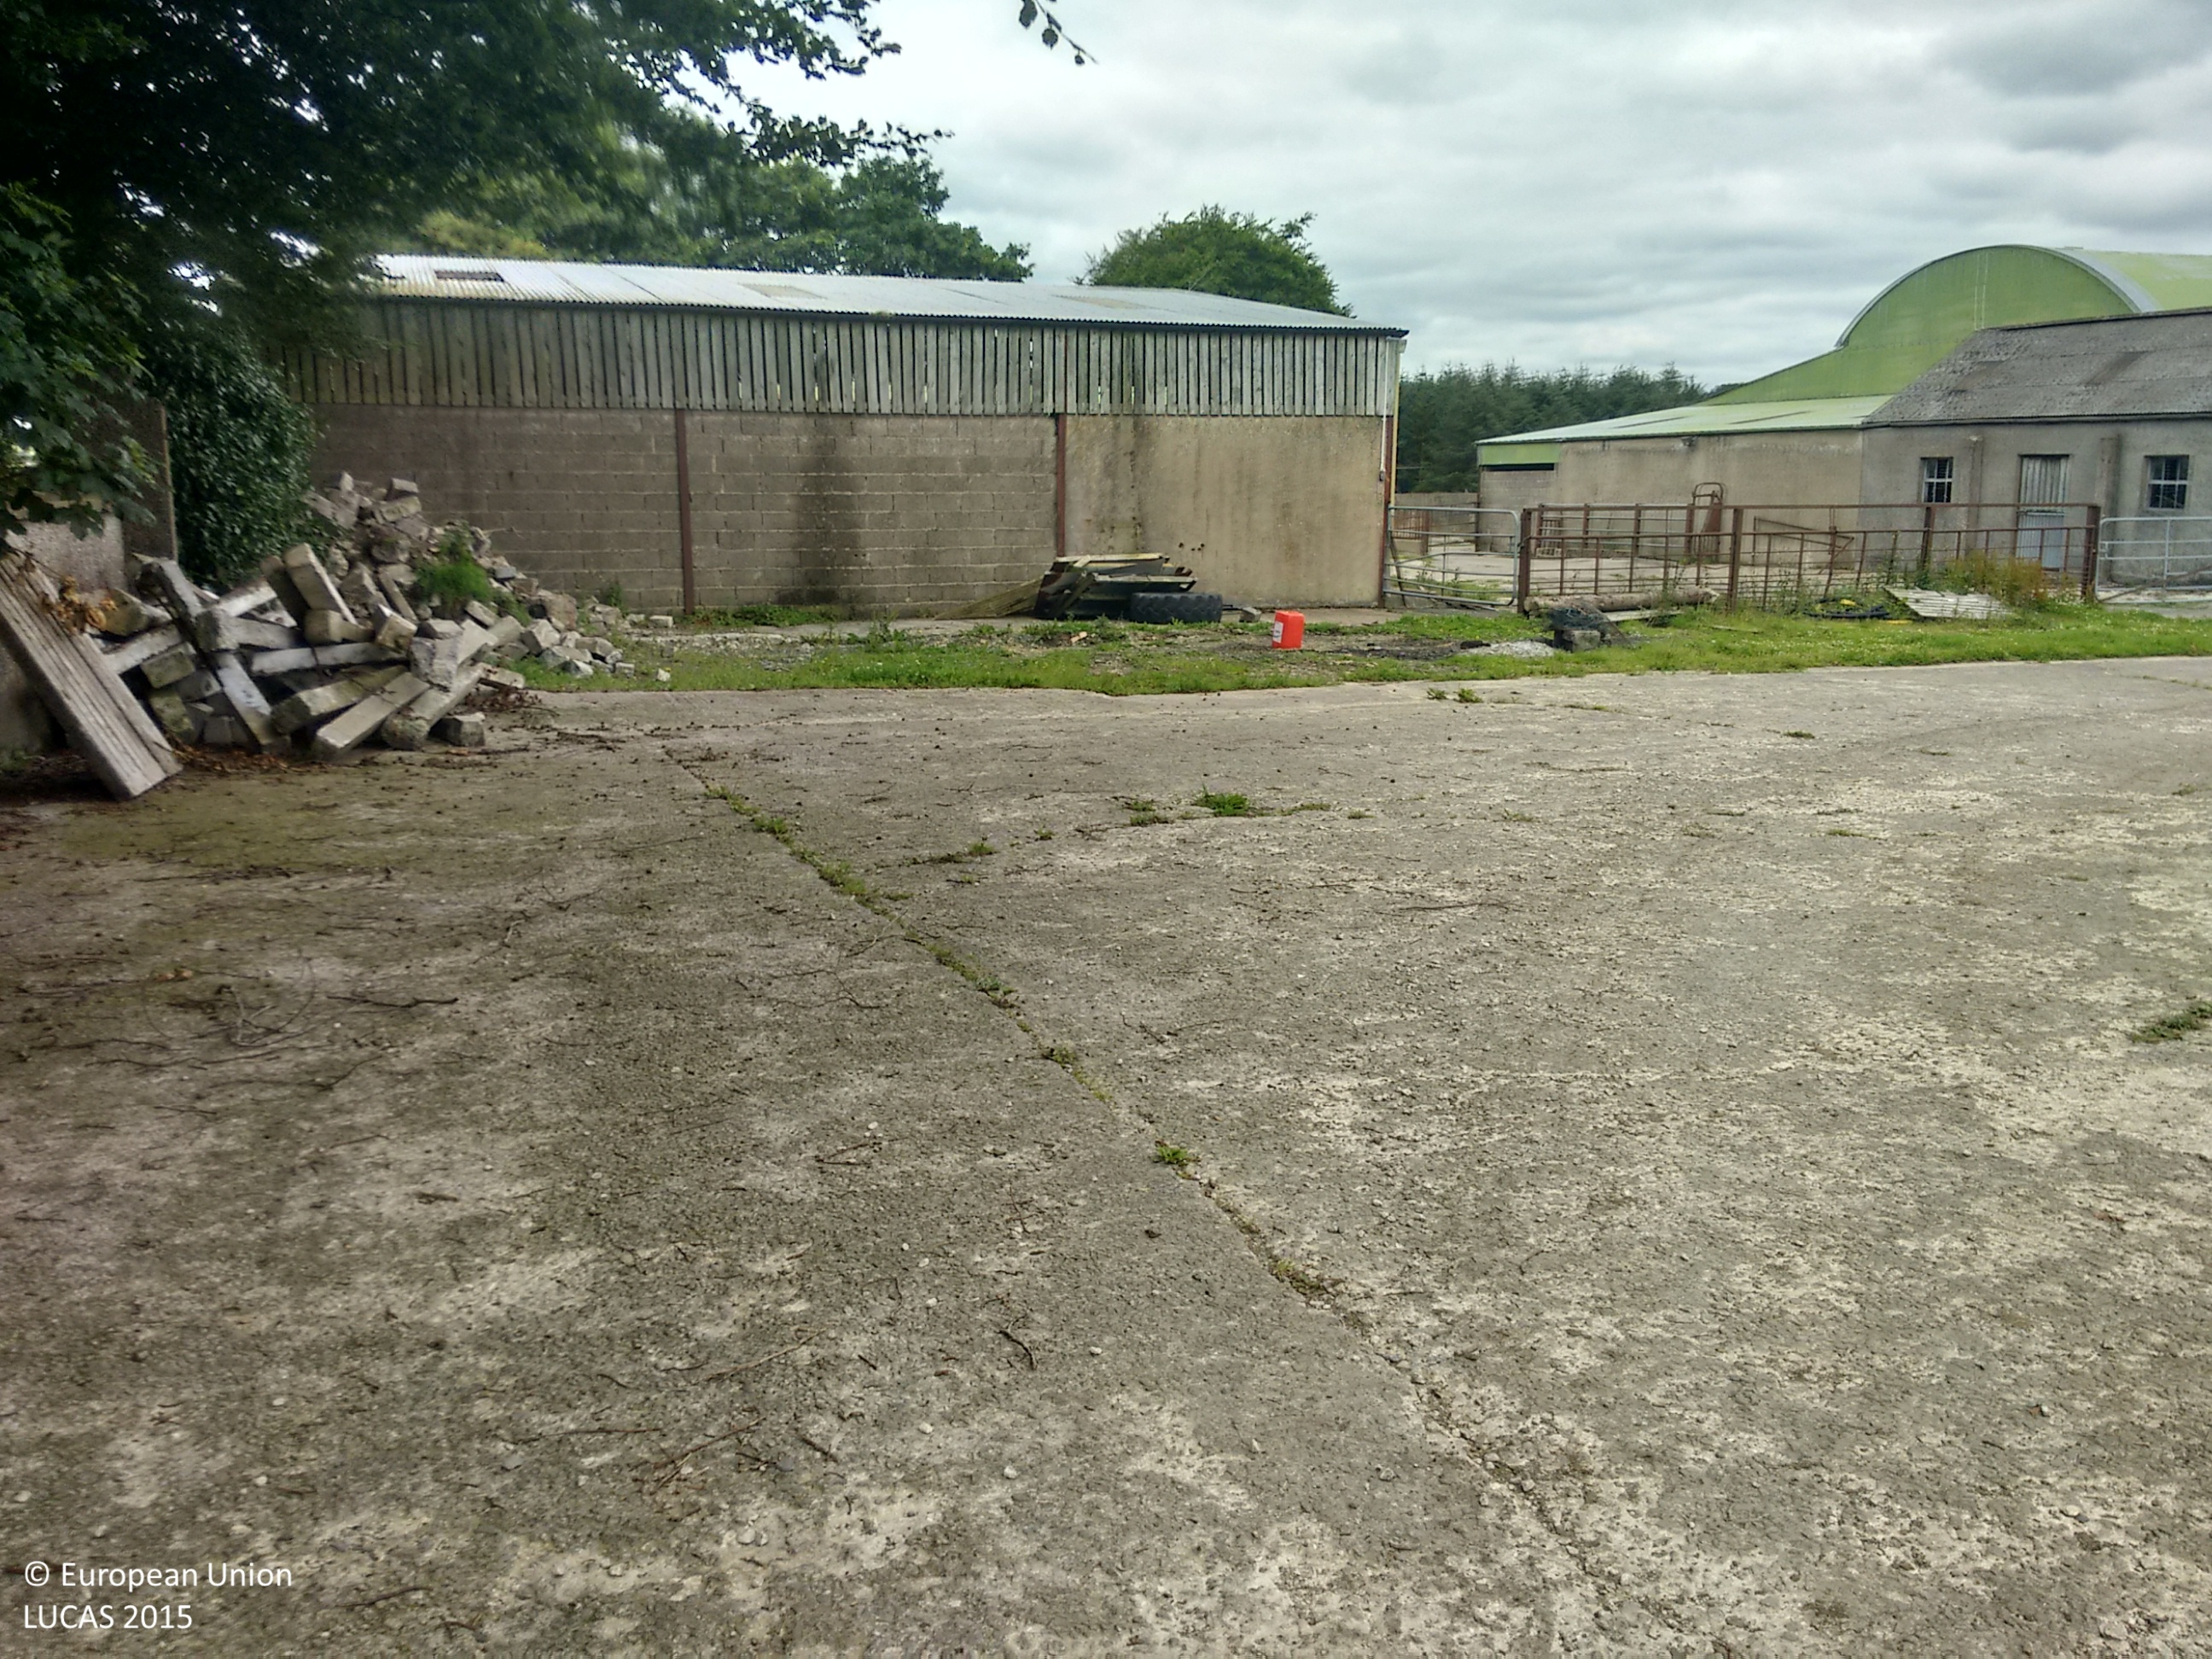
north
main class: Grassland
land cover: Grassland without tree/shrub cover
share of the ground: > 75 %
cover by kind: herbaceous plants 100 %
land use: Agriculture (excluding fallow land and kitchen gardens)
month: August
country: GB
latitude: 54.1712
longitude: -6.6271
